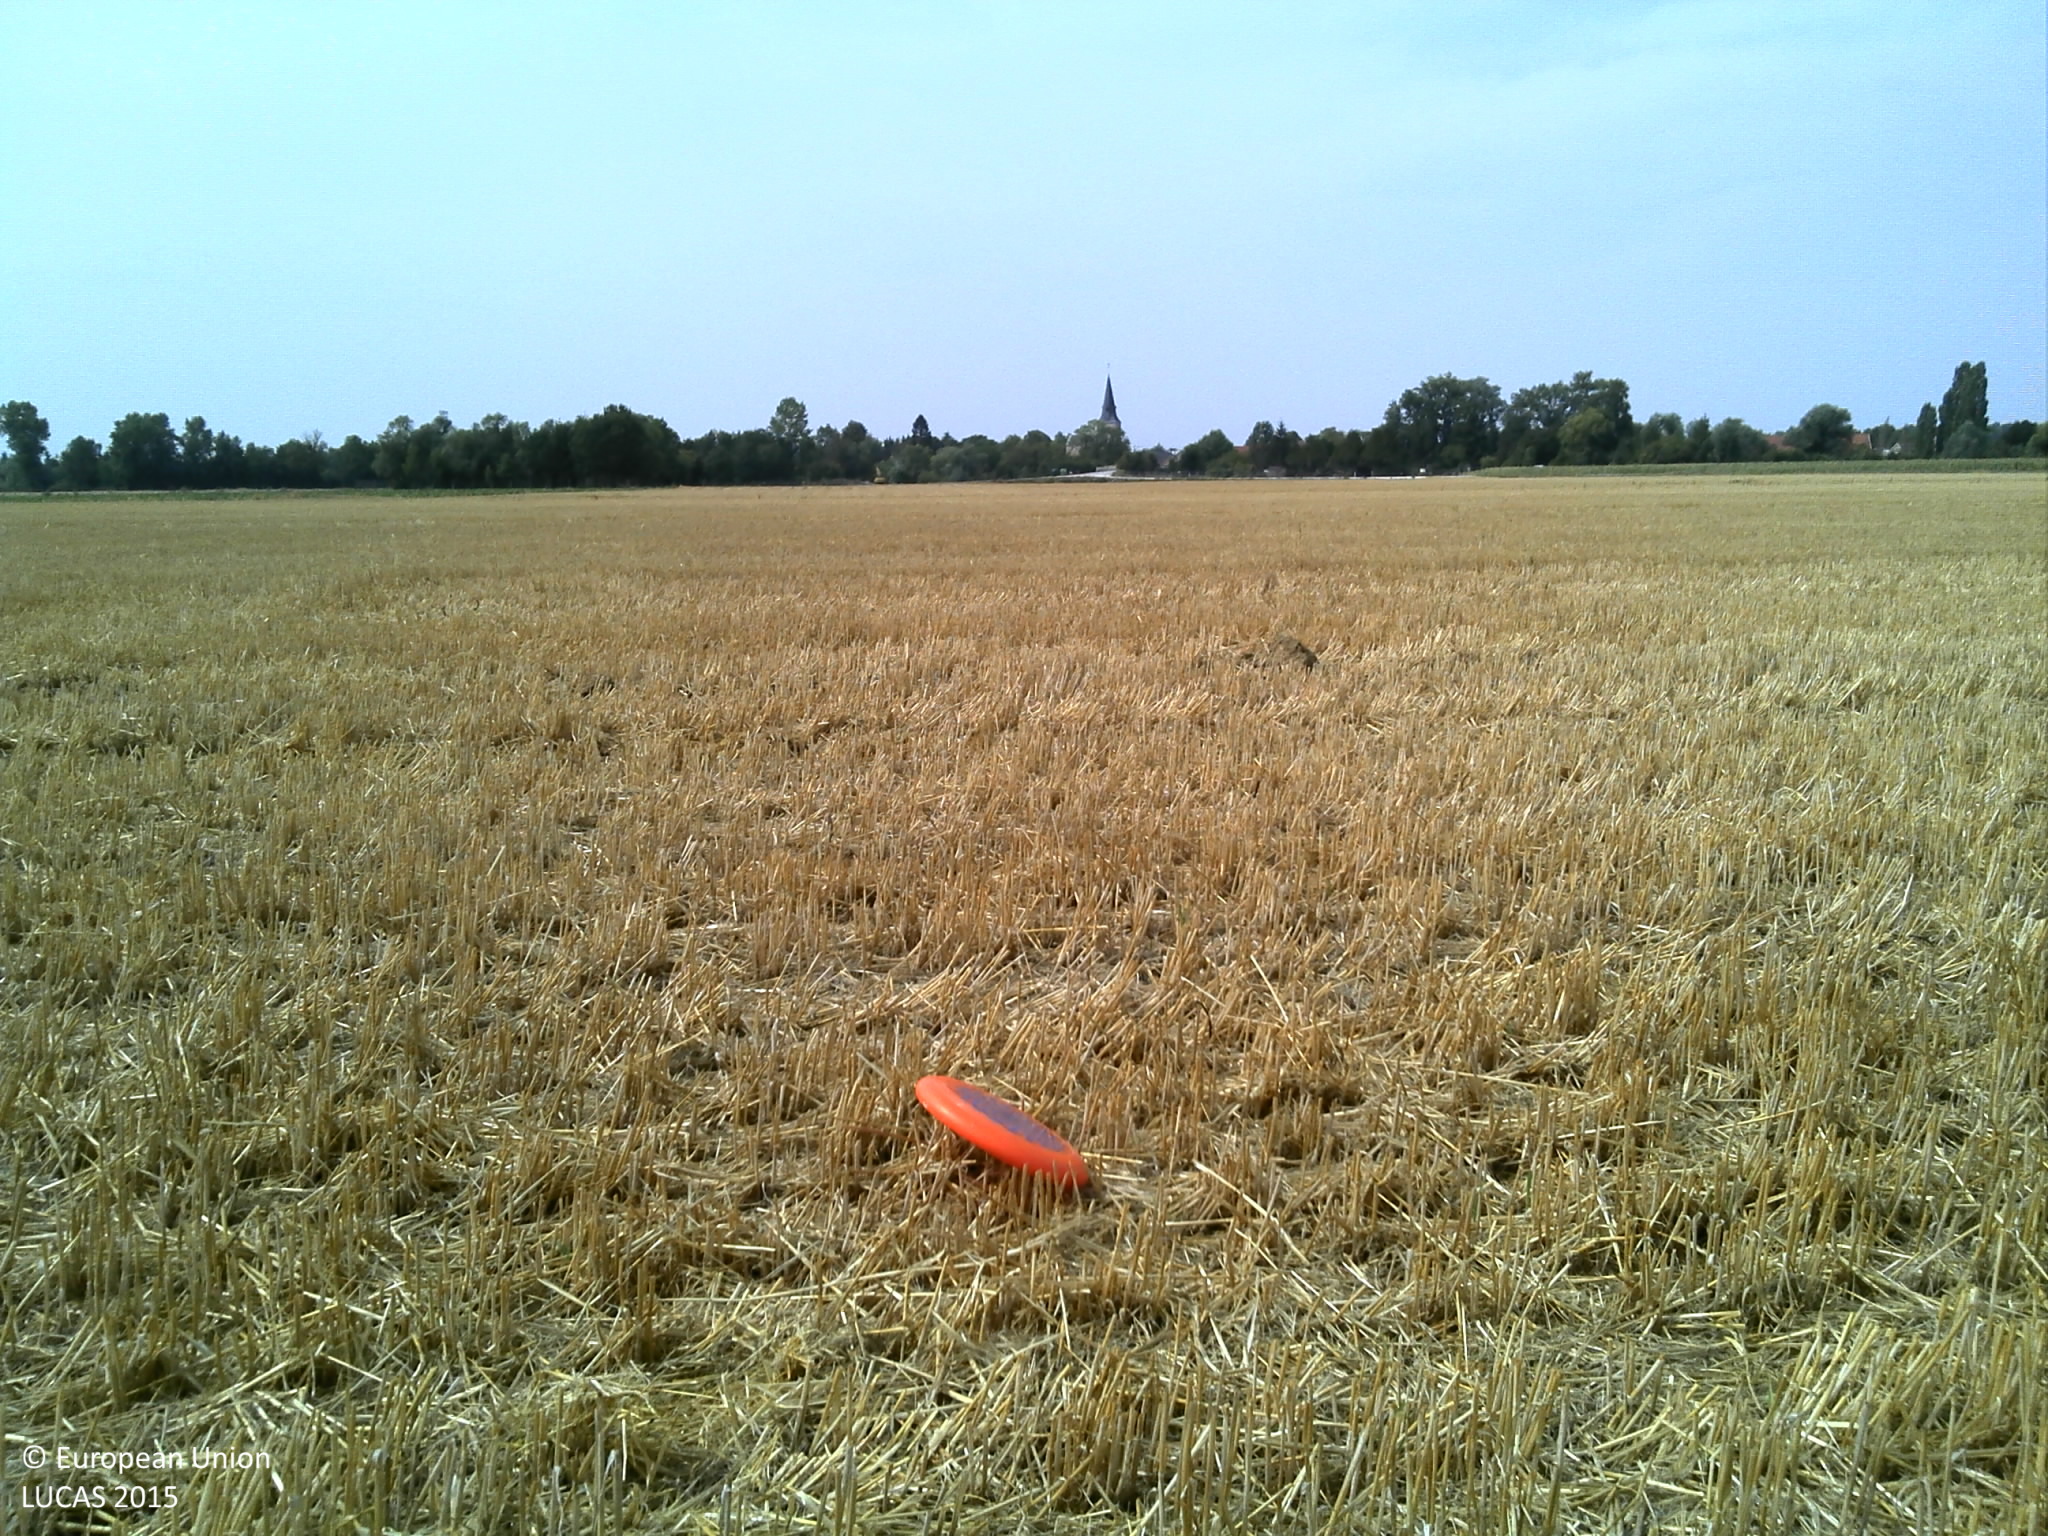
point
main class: Cropland
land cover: Barley
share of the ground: > 75 %
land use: Agriculture (excluding fallow land and kitchen gardens)
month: August
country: FR
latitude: 49.0095
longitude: 4.2128
